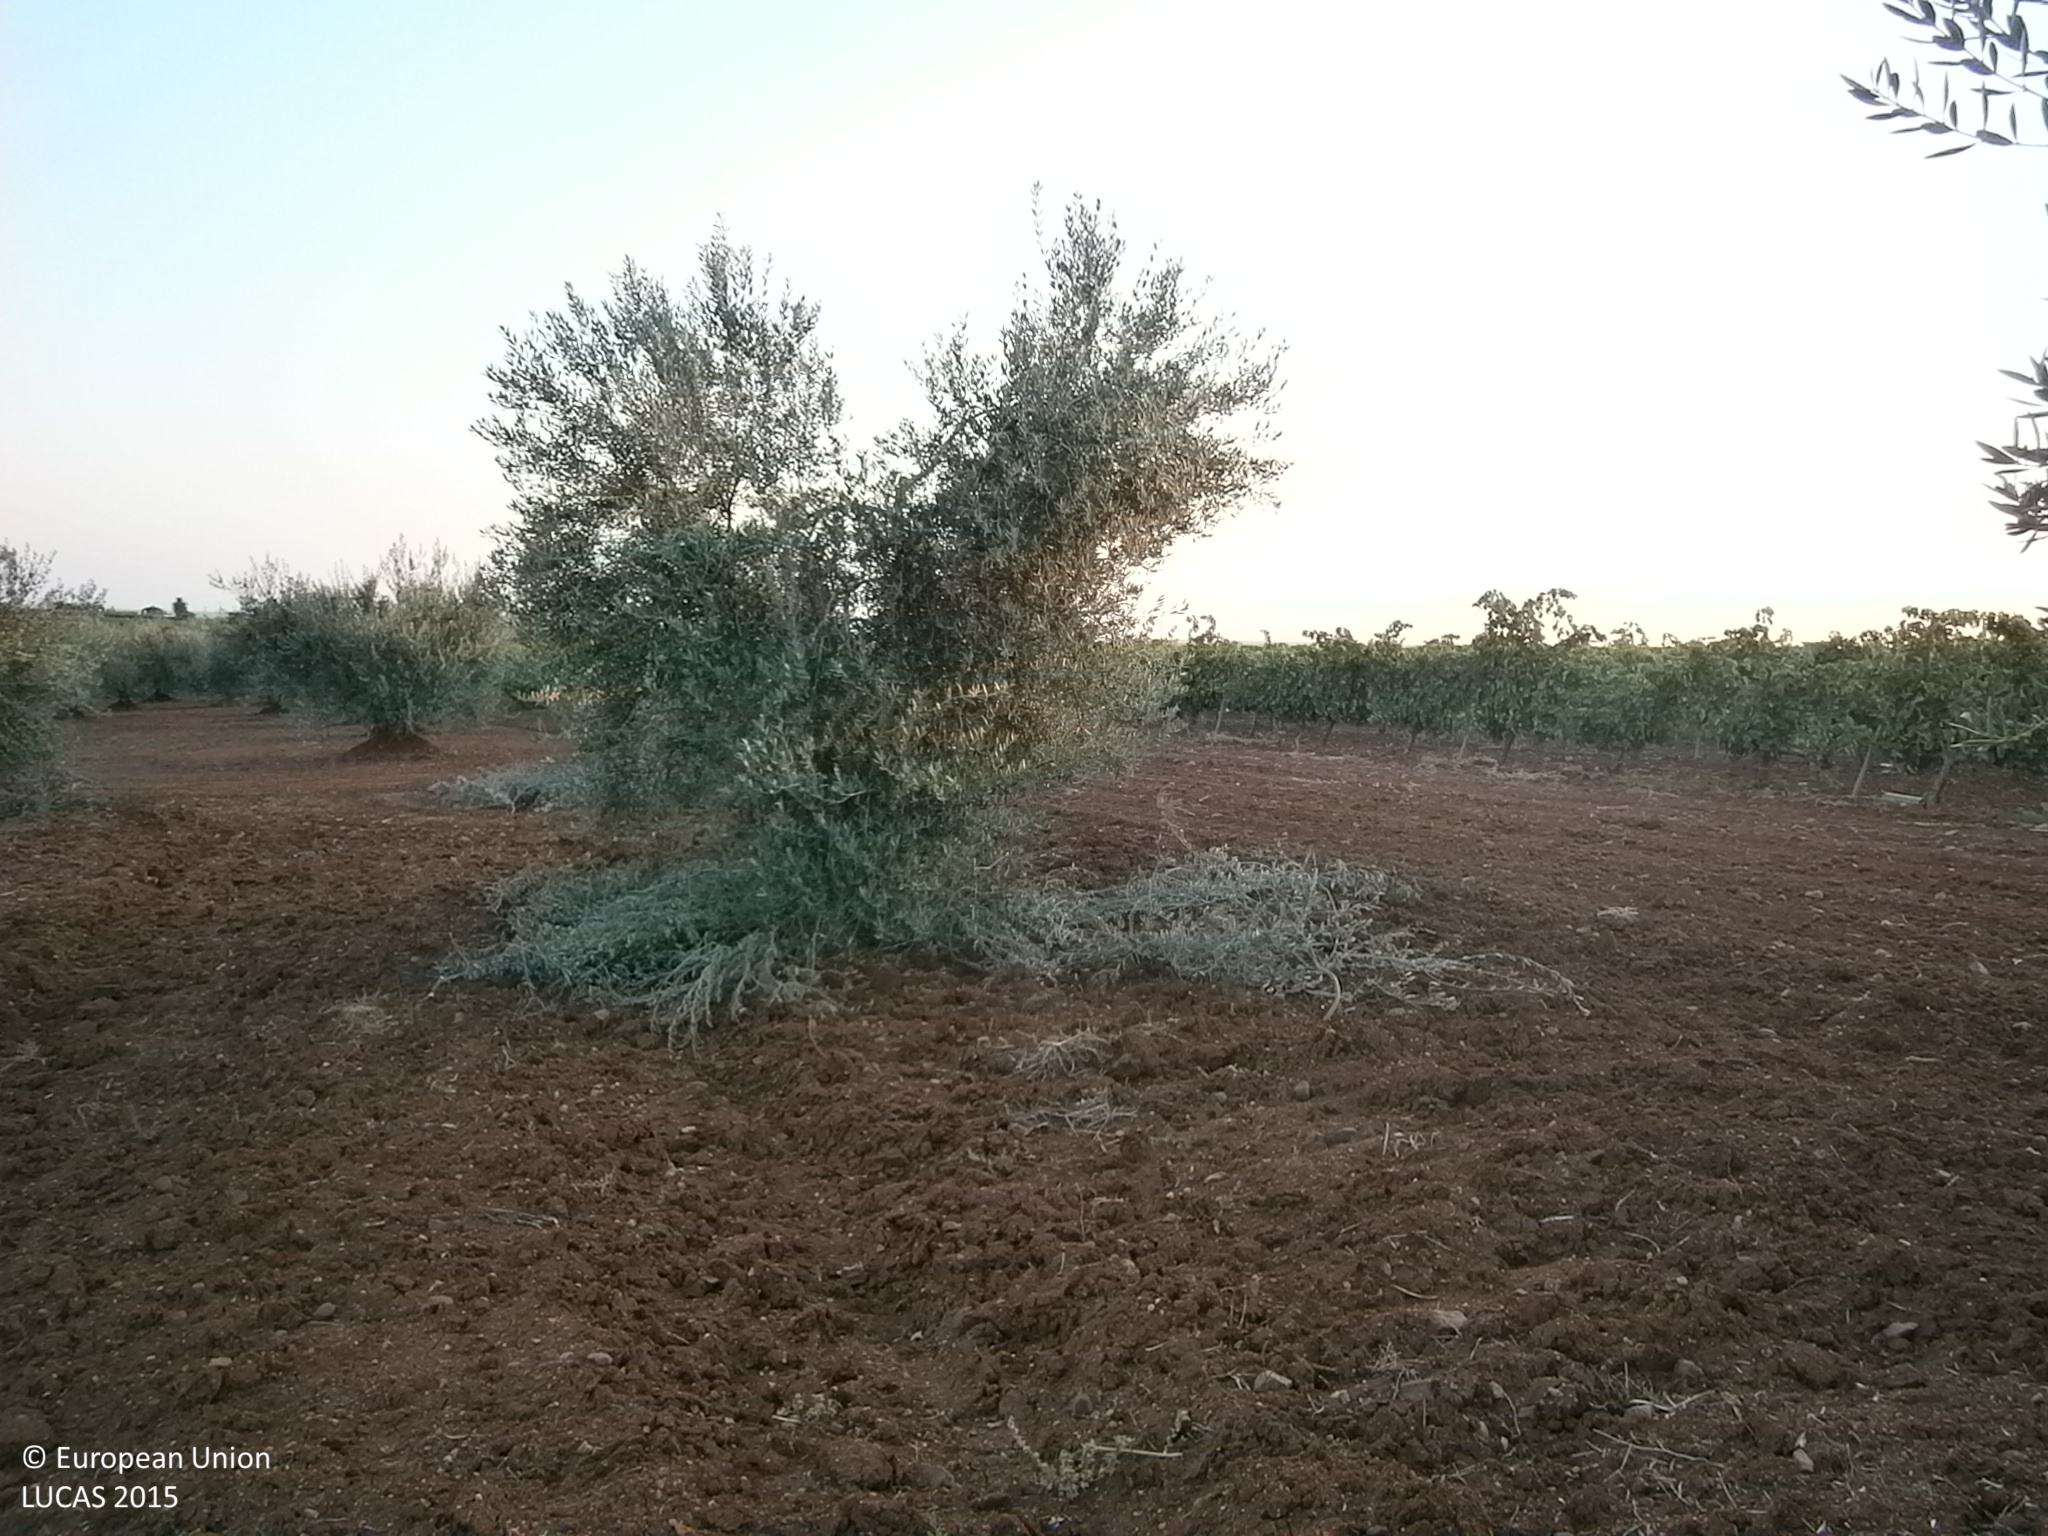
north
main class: Cropland
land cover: Olive groves
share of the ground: 25 - 50 %
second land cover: Other bare soil
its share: > 75 %
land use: Agriculture (excluding fallow land and kitchen gardens)
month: June
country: ES
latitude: 38.6253
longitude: -6.6799
